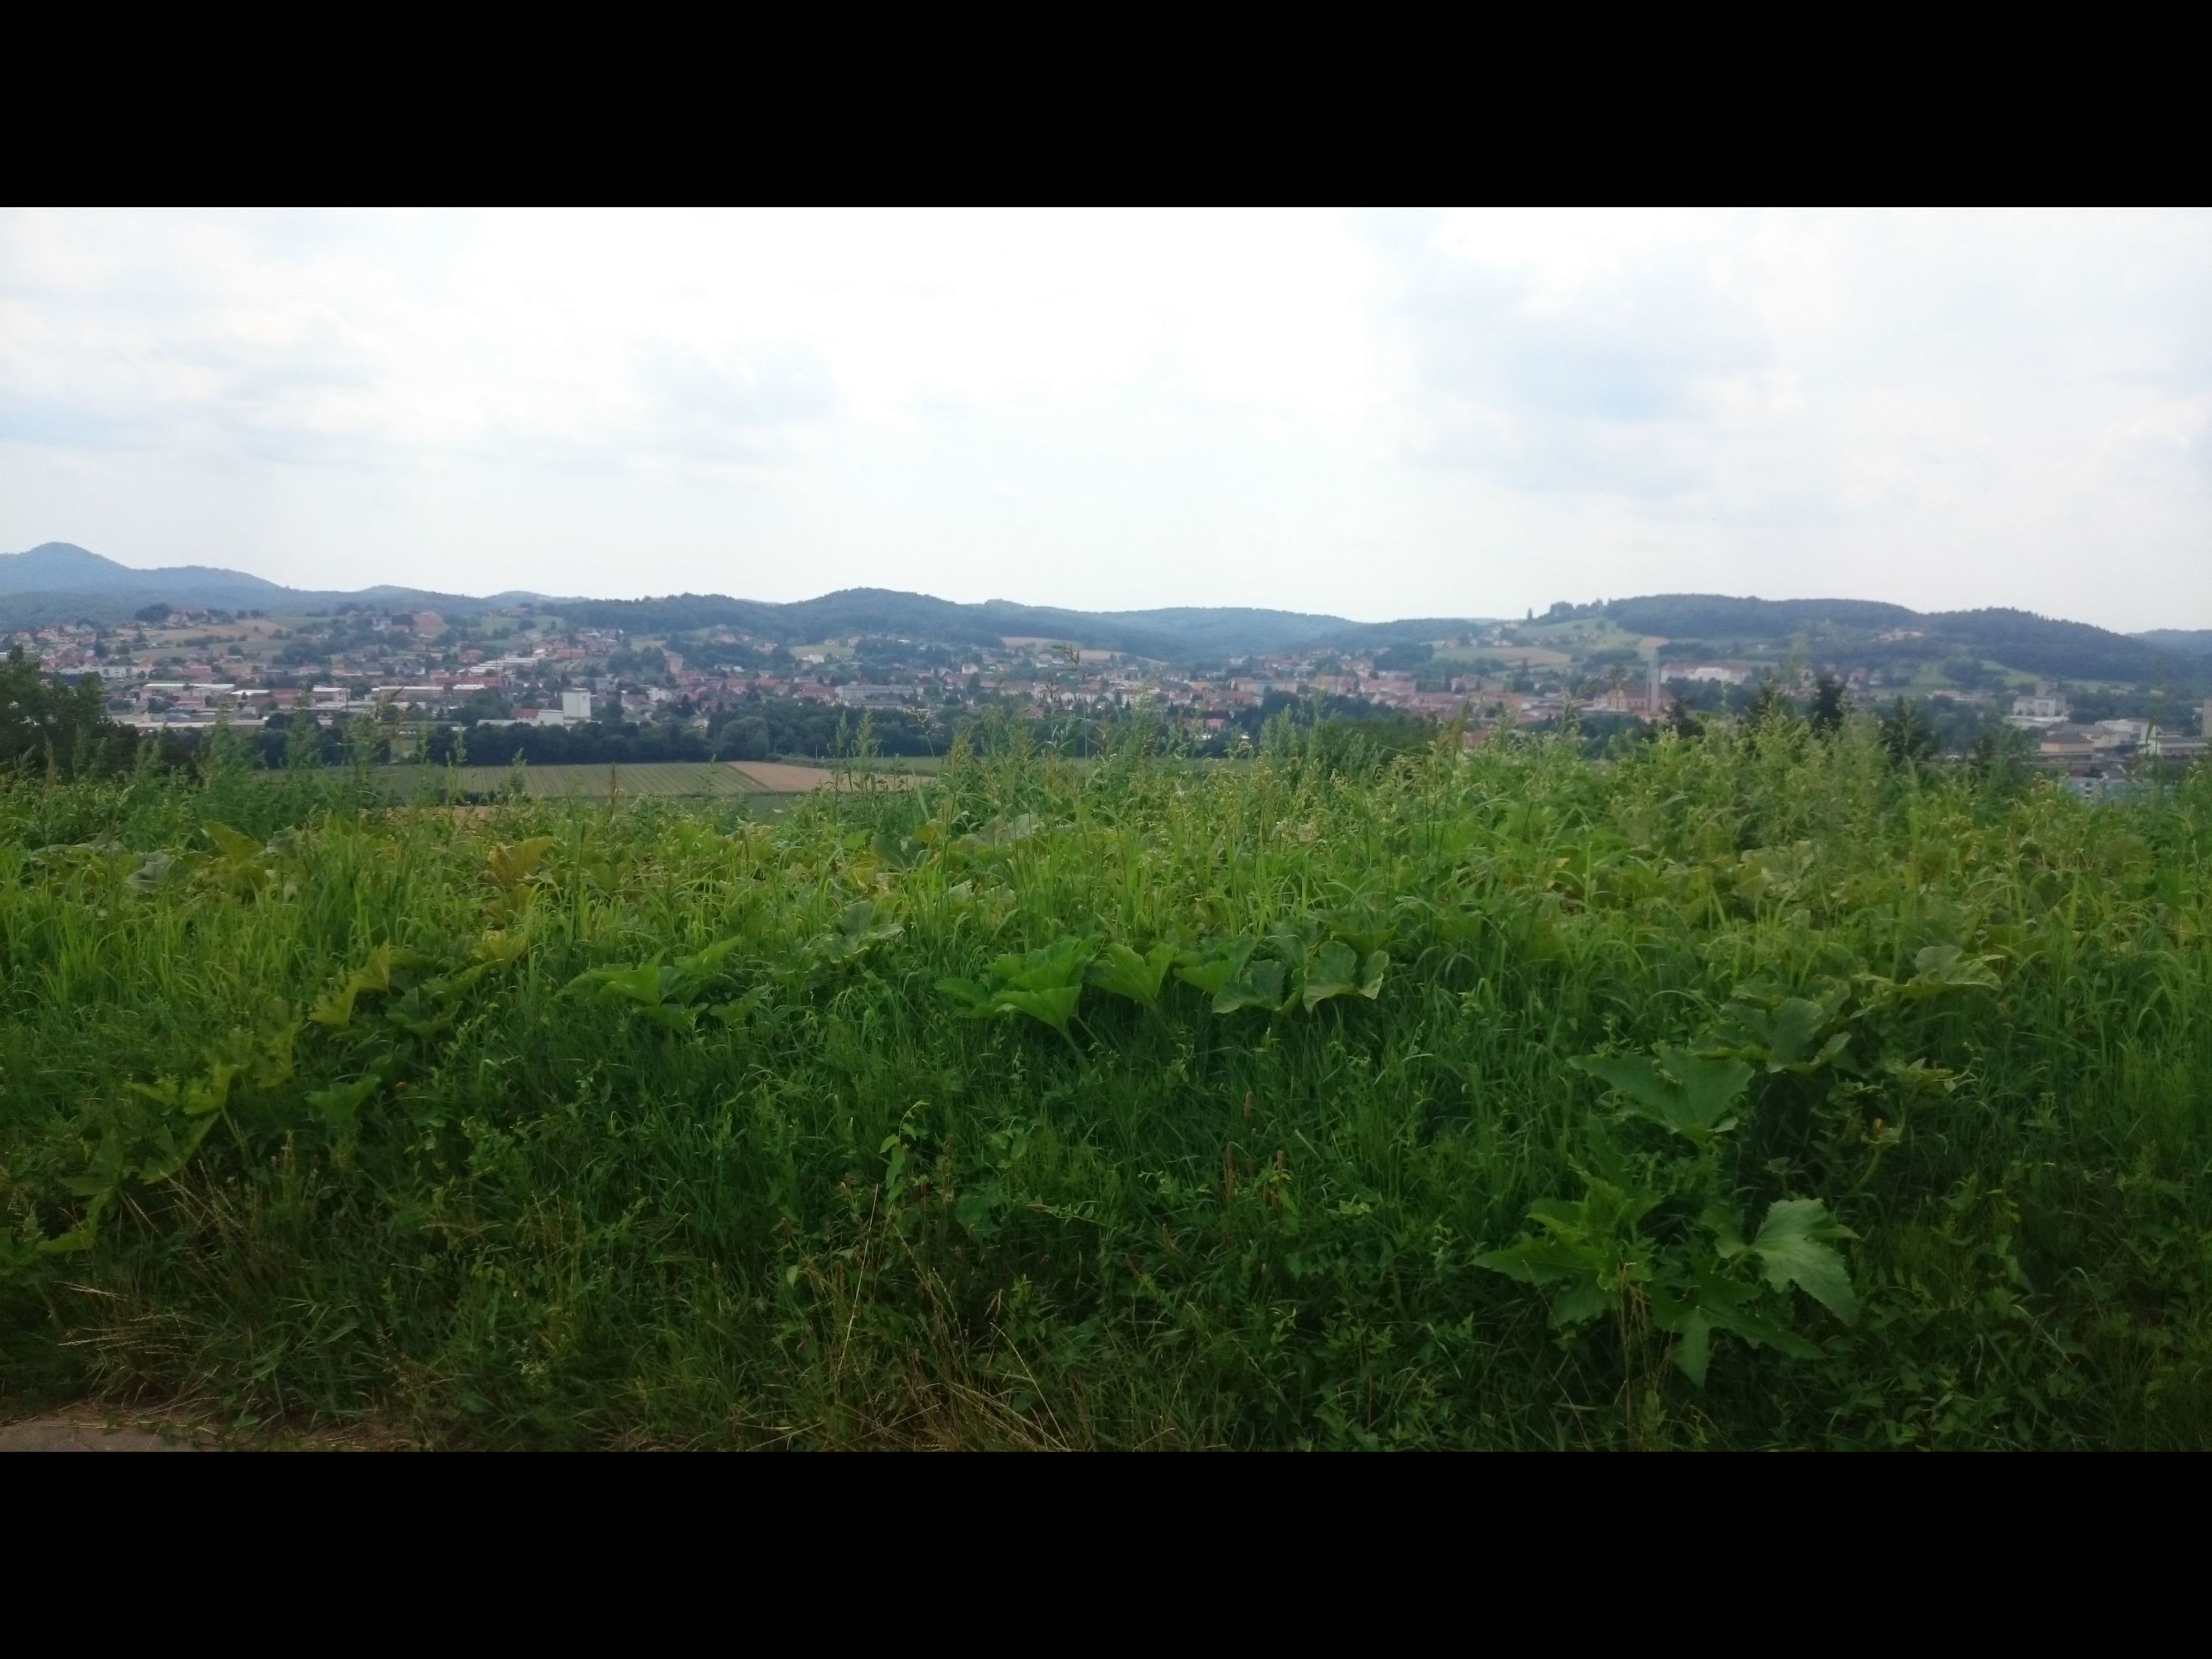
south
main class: Cropland
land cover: Maize
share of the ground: > 75 %
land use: Agriculture (excluding fallow land and kitchen gardens)
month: July
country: AT
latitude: 46.9646
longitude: 15.9016
